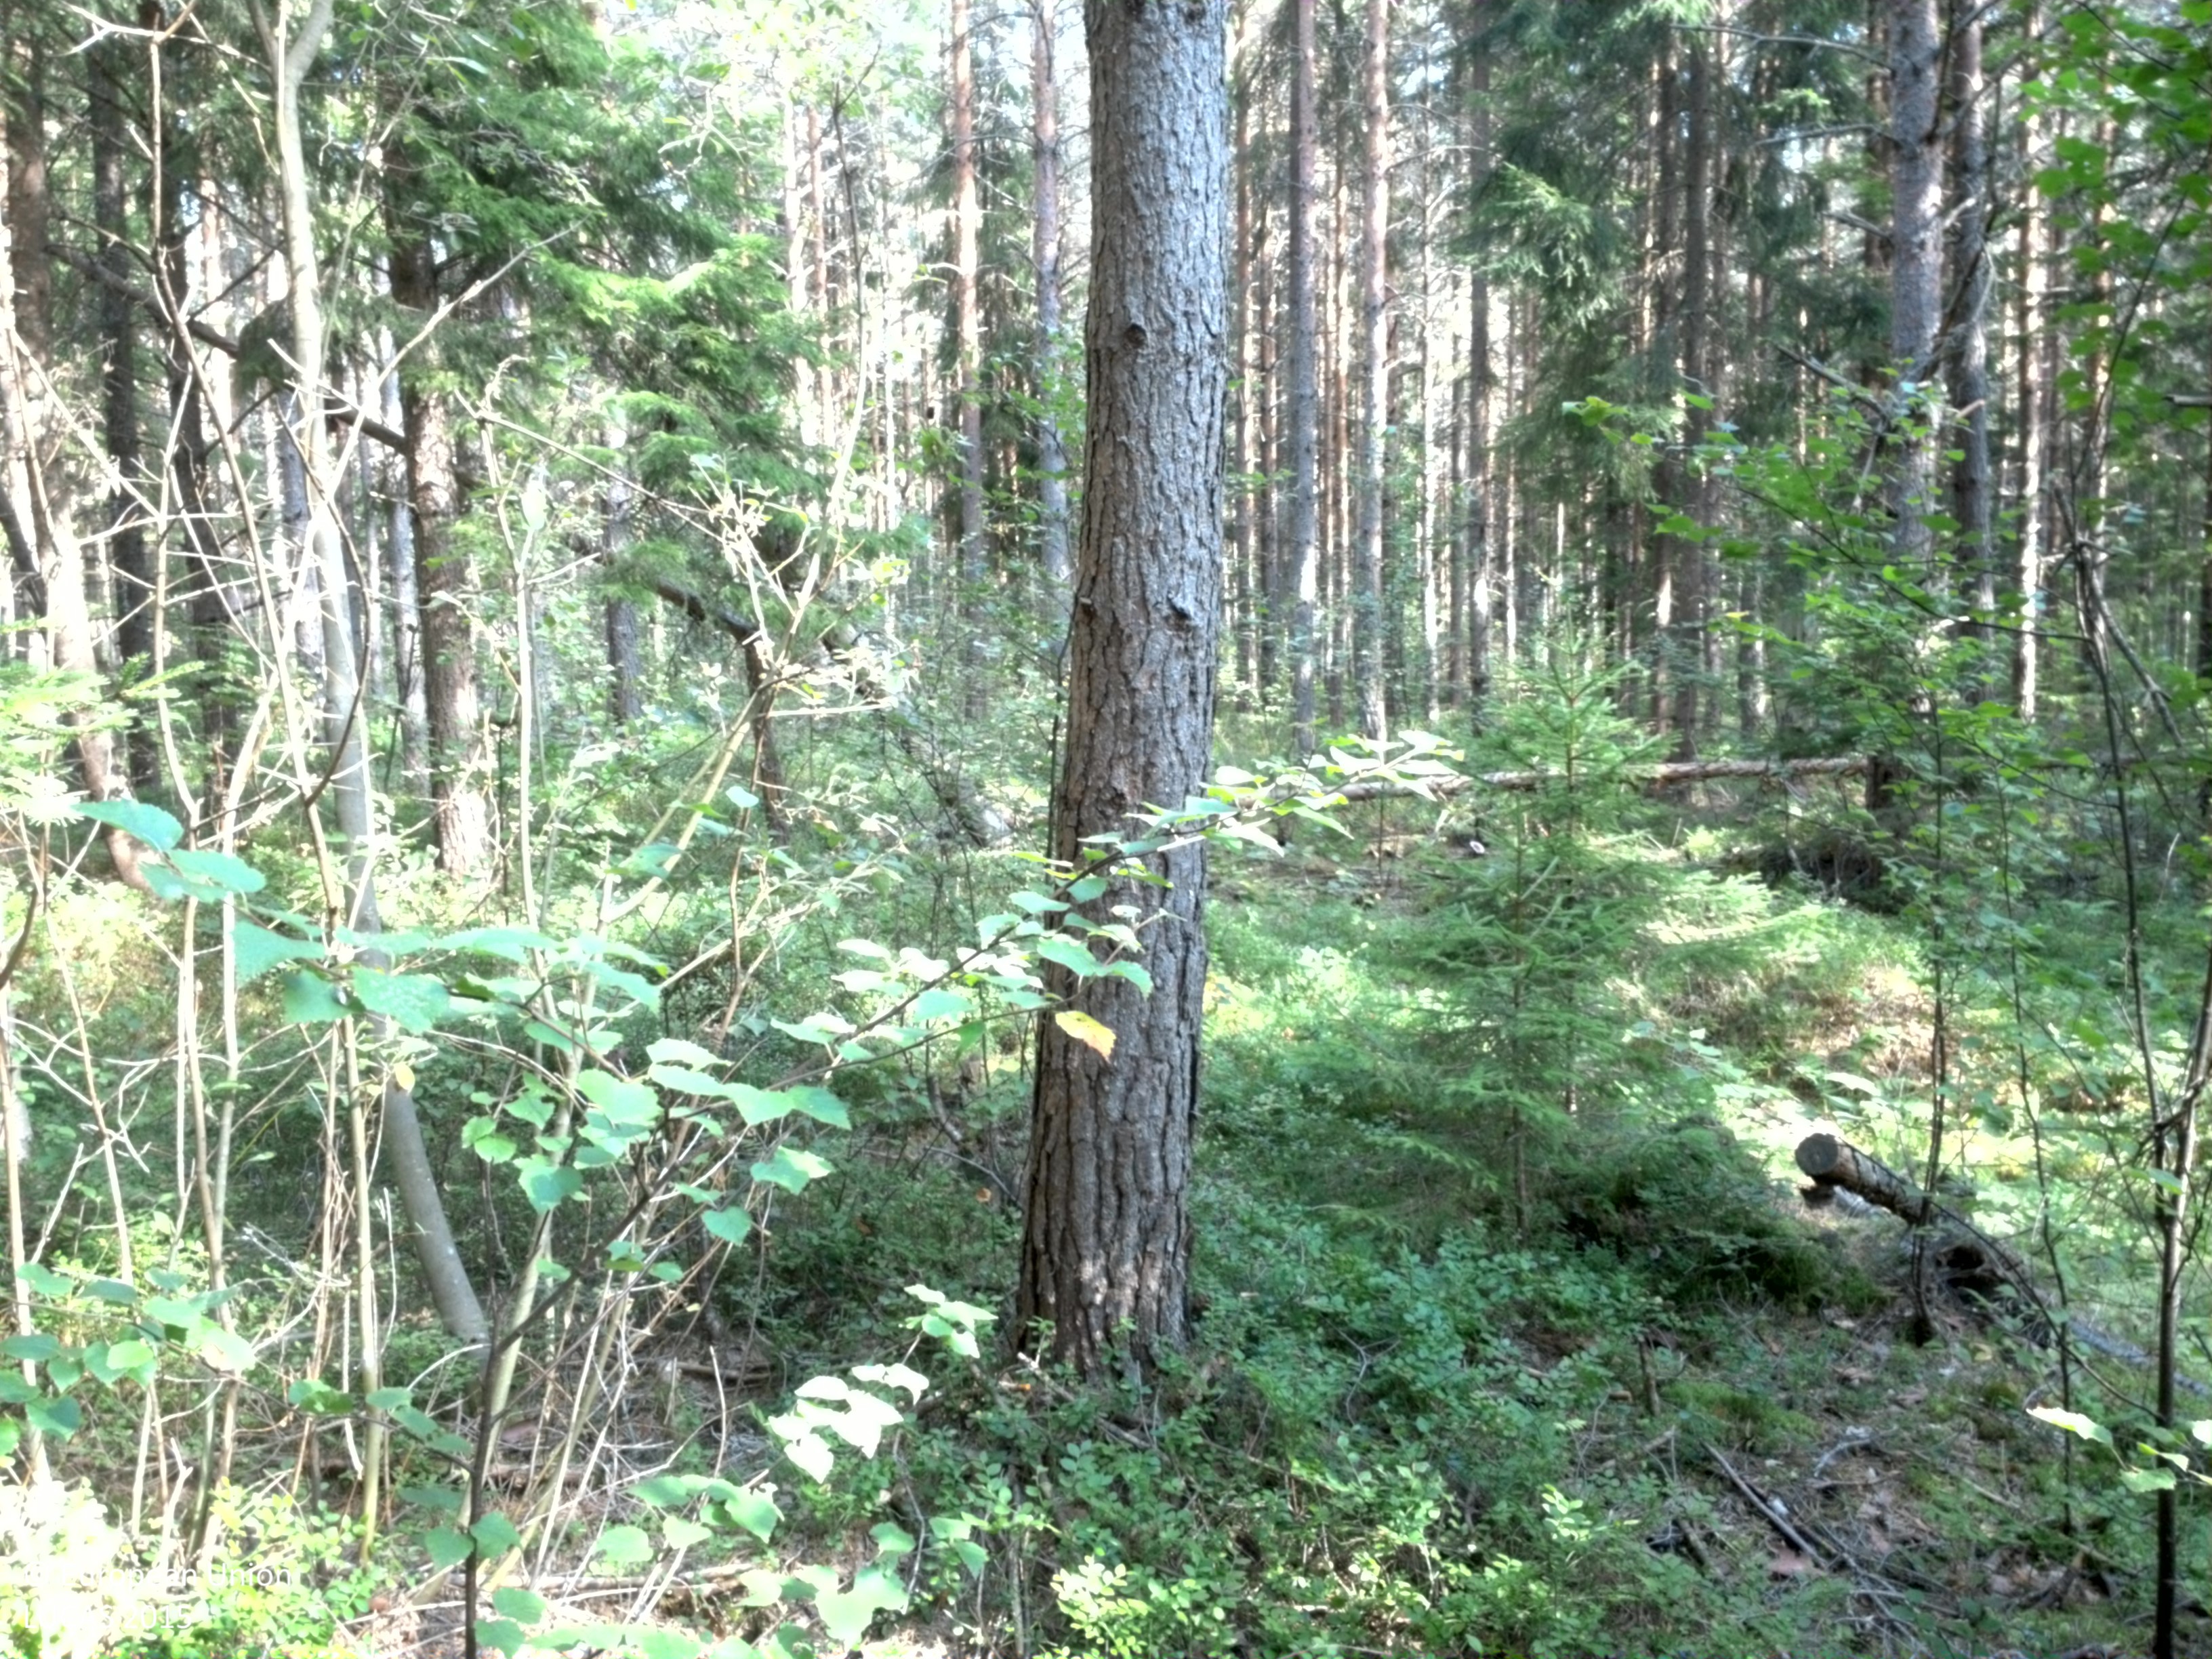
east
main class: Woodland
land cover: Pine dominated coniferous woodland
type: boreal forest
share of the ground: > 75 %
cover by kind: coniferous forest trees 70 %, shrubs 15 %, broadleaved forest trees 10 %, lichens and mosses 5 %
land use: Forestry
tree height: > 5 m
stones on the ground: < 10 %
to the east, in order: Pine dominated coniferous woodland; Pine dominated mixed woodland
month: August
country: SE
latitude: 59.8302
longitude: 15.7164
